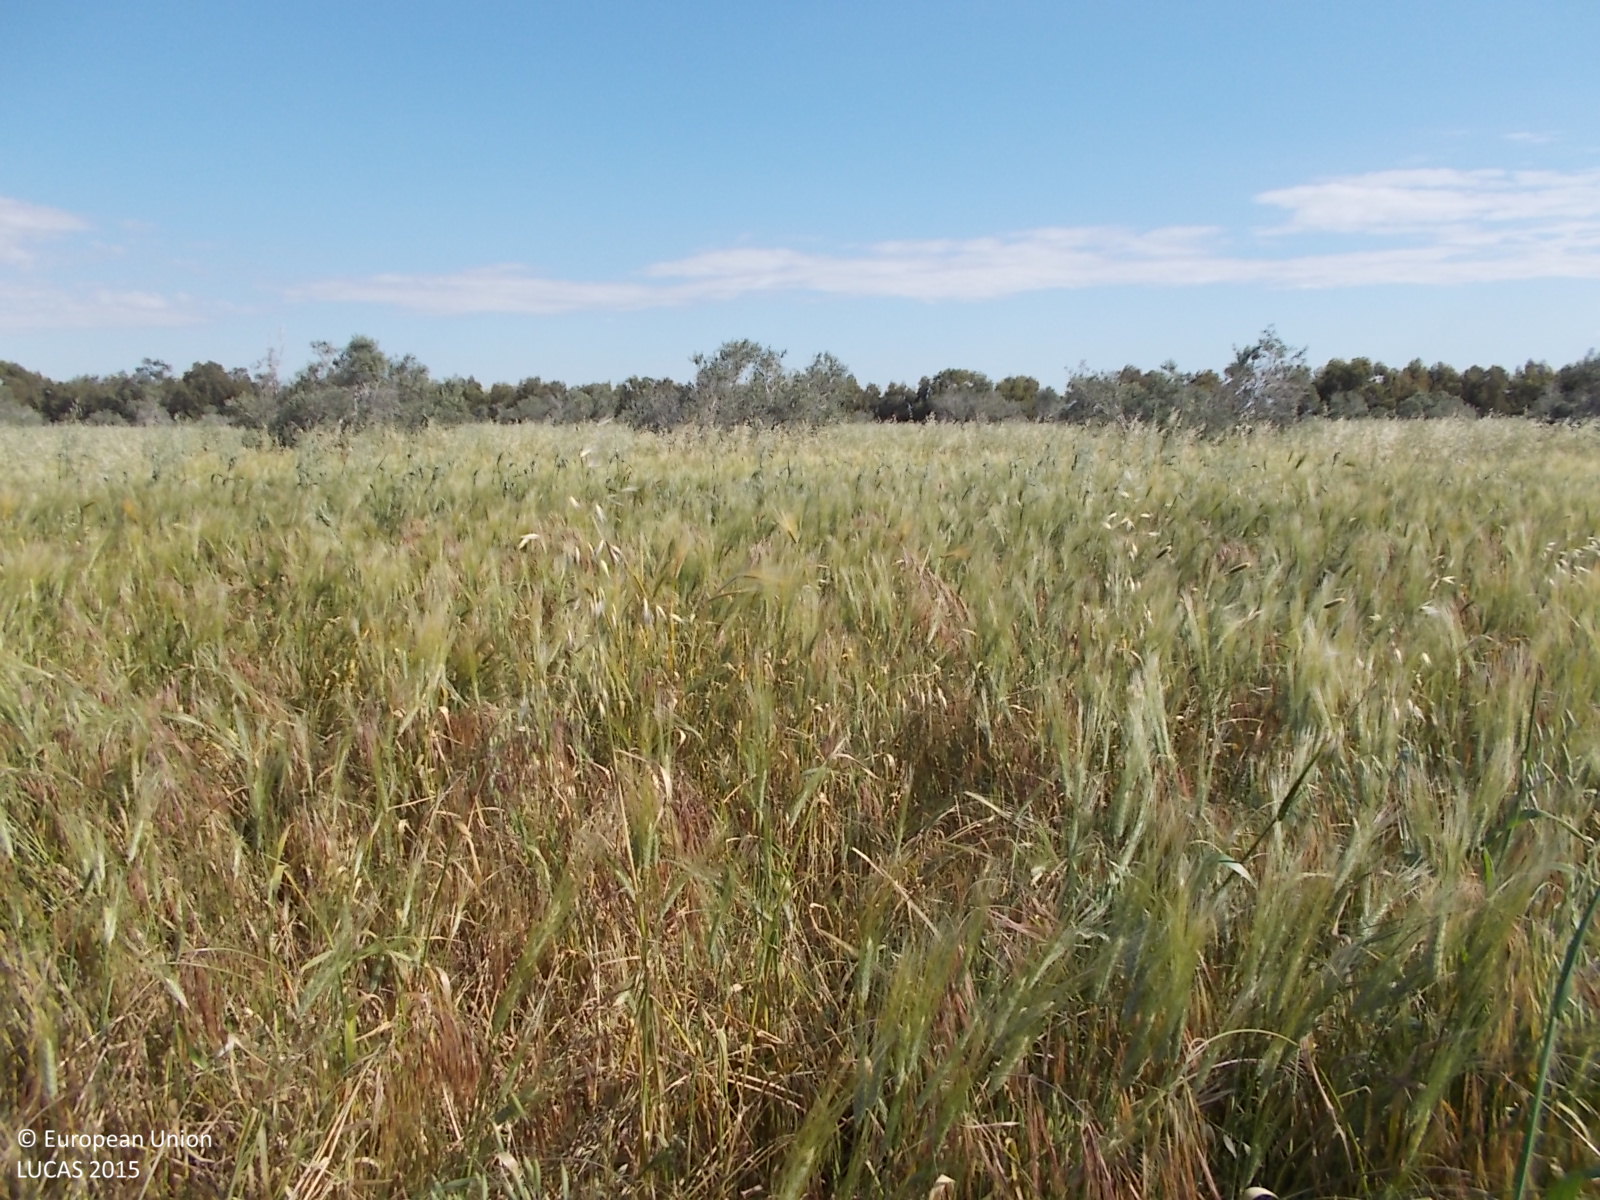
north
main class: Cropland
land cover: Mixed cereals for fodder
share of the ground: > 75 %
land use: Agriculture (excluding fallow land and kitchen gardens)
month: April
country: CY
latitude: 34.8431
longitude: 33.6068
